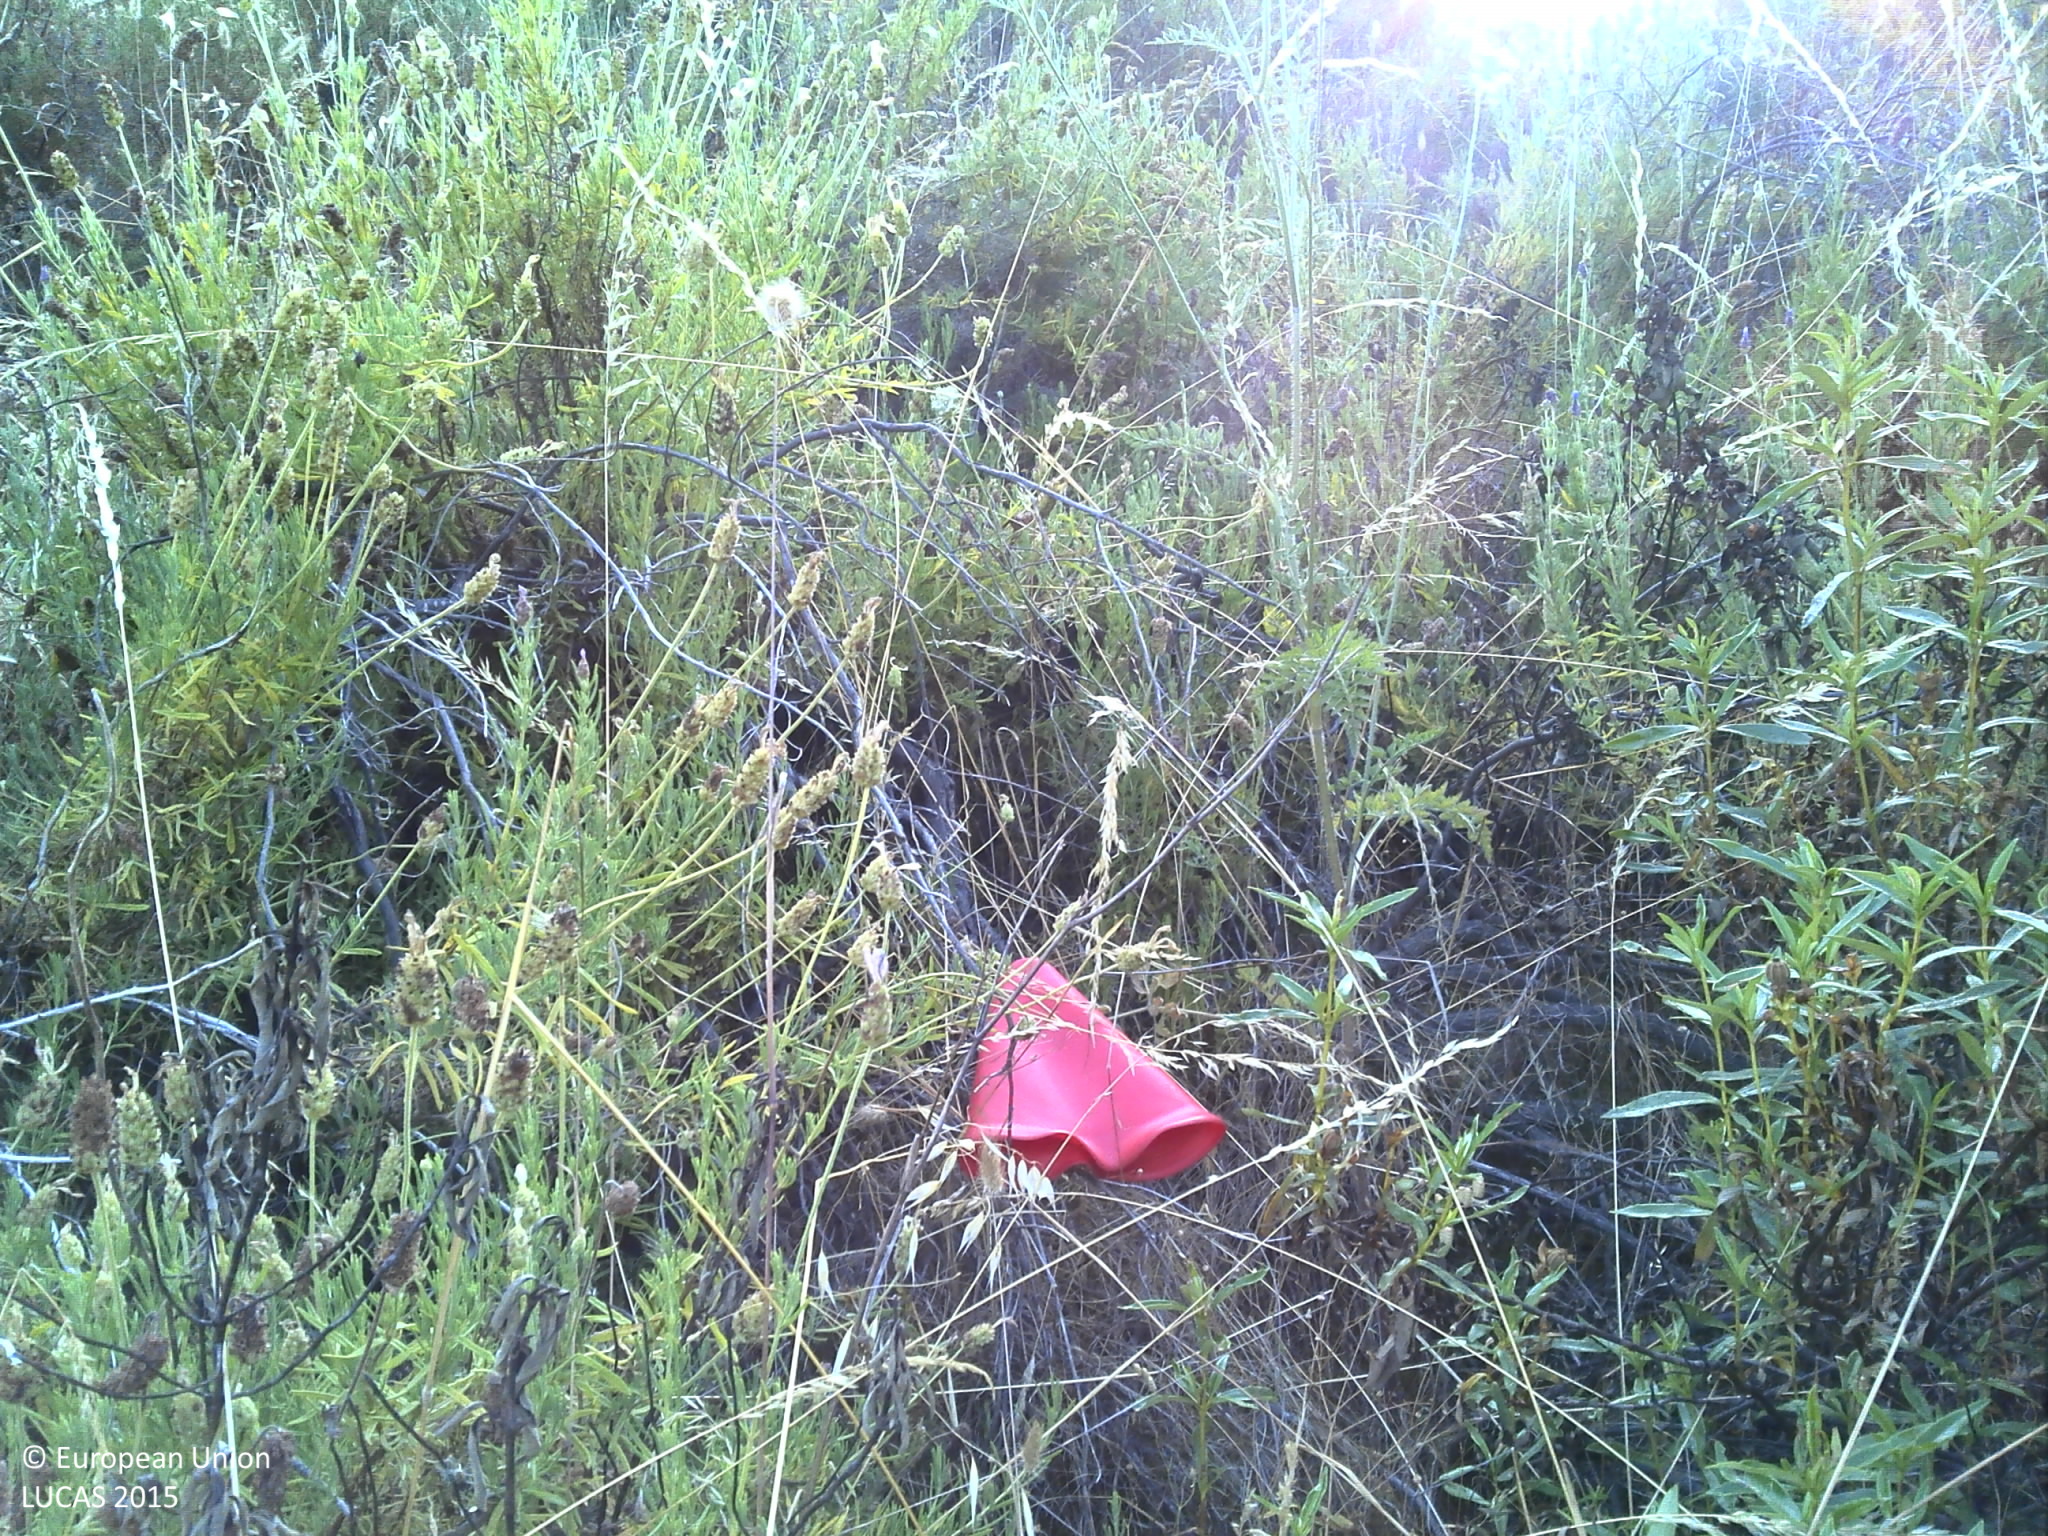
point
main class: Shrubland
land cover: Shrubland with sparse tree cover
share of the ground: > 75 %
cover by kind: shrubs 95 %, broadleaved forest trees 5 %
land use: Abandoned areas
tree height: < 5 m
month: June
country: PT
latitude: 37.7465
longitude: -7.4566
